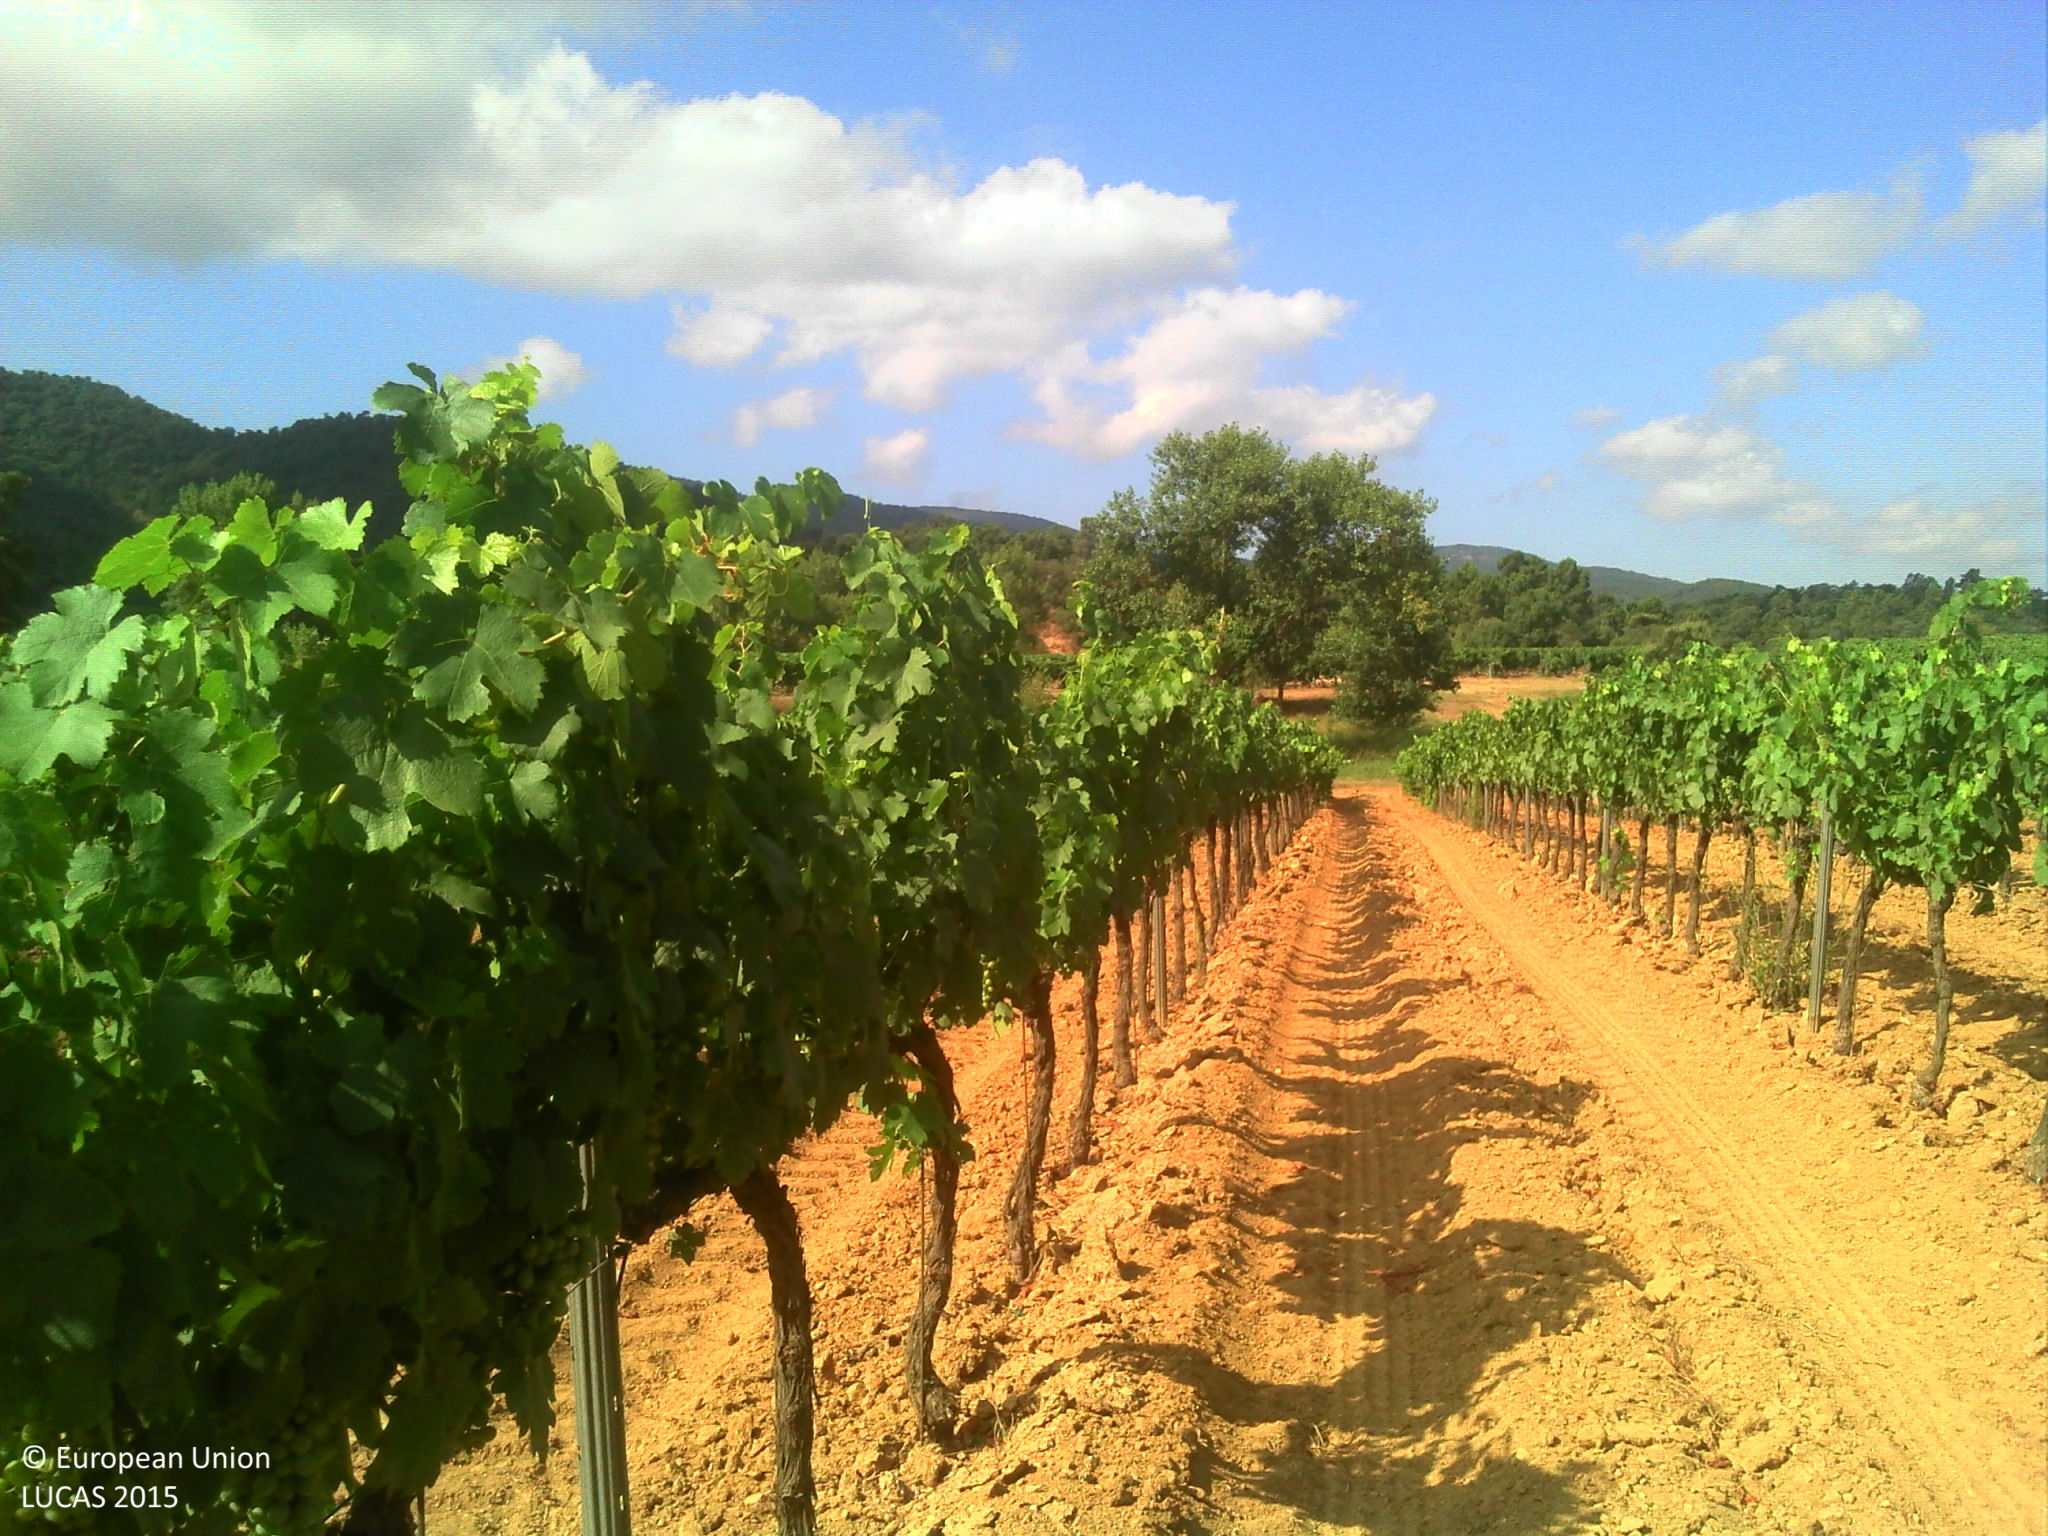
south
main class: Cropland
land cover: Vineyards
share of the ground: 25 - 50 %
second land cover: Other bare soil
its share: > 75 %
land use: Agriculture (excluding fallow land and kitchen gardens)
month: July
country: FR
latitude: 43.2055
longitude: 6.4277
